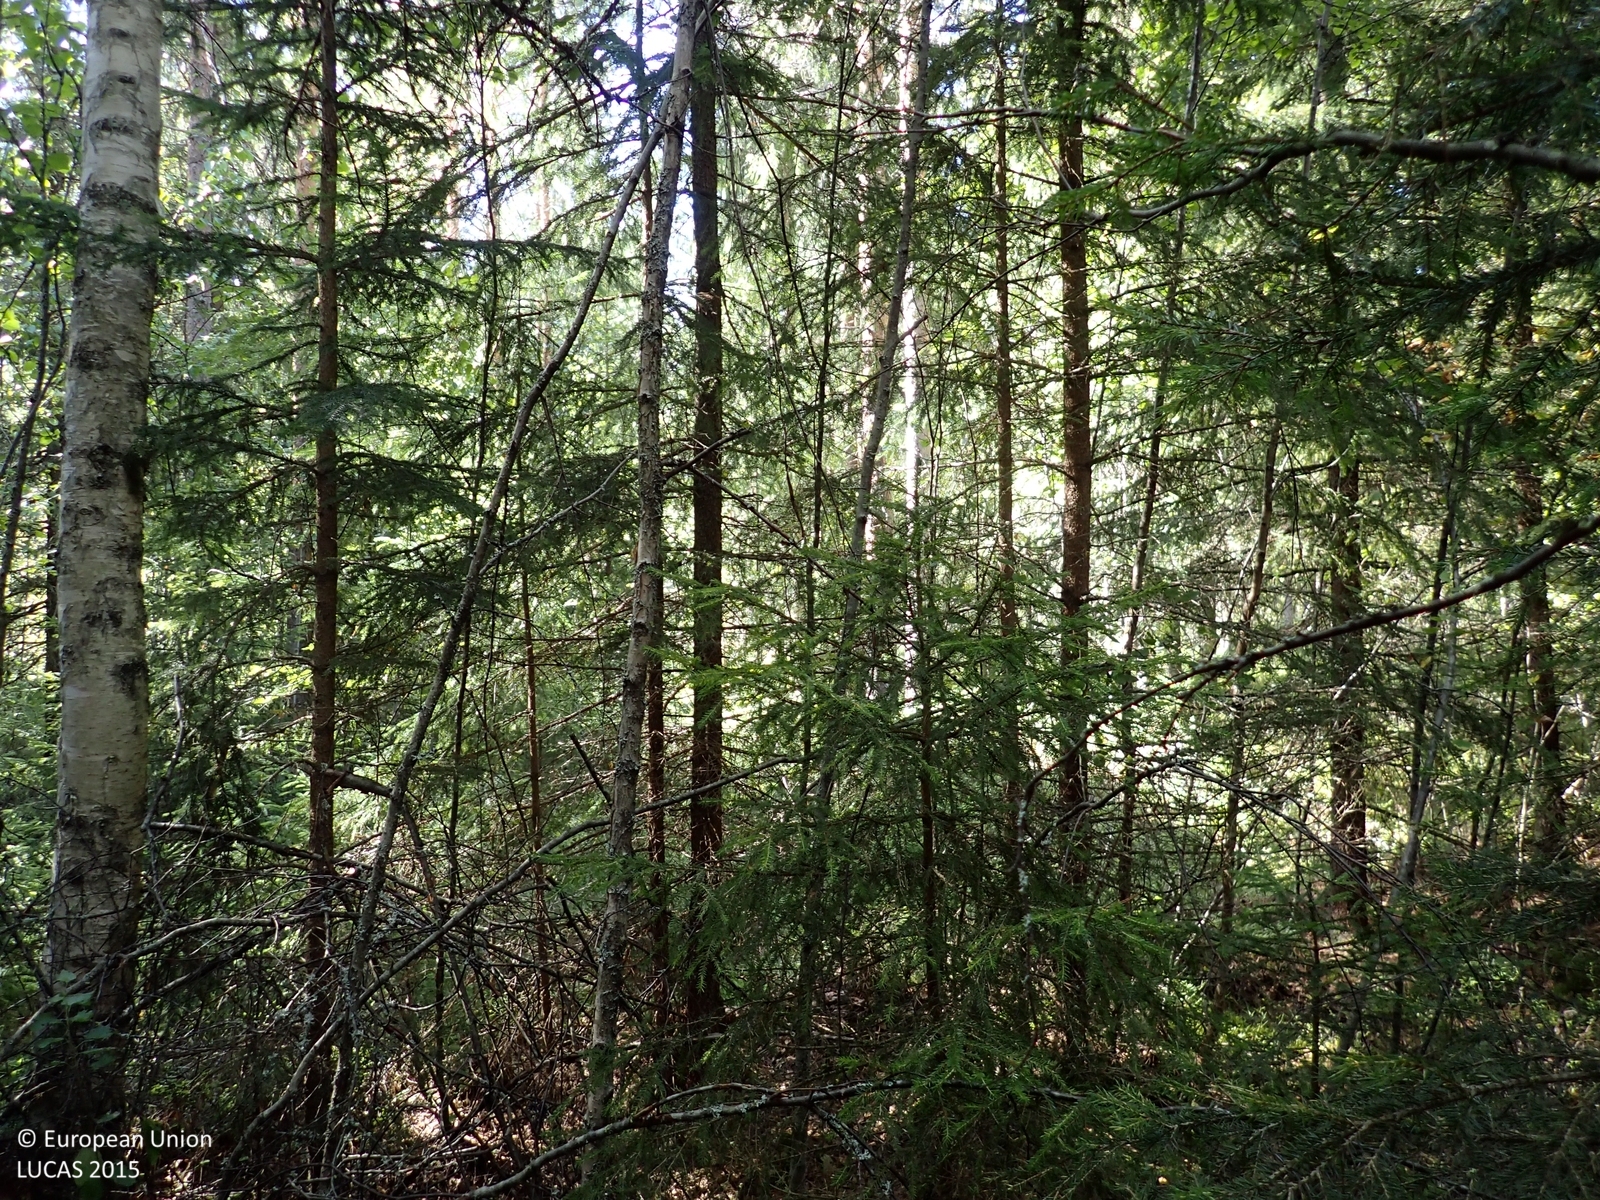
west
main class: Woodland
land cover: Other mixed woodland
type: boreal forest
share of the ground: > 75 %
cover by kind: coniferous forest trees 60 %, broadleaved forest trees 25 %, shrubs 10 %, lichens and mosses 5 %
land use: Forestry
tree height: > 5 m
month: August
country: FI
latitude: 62.2809
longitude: 23.0350
